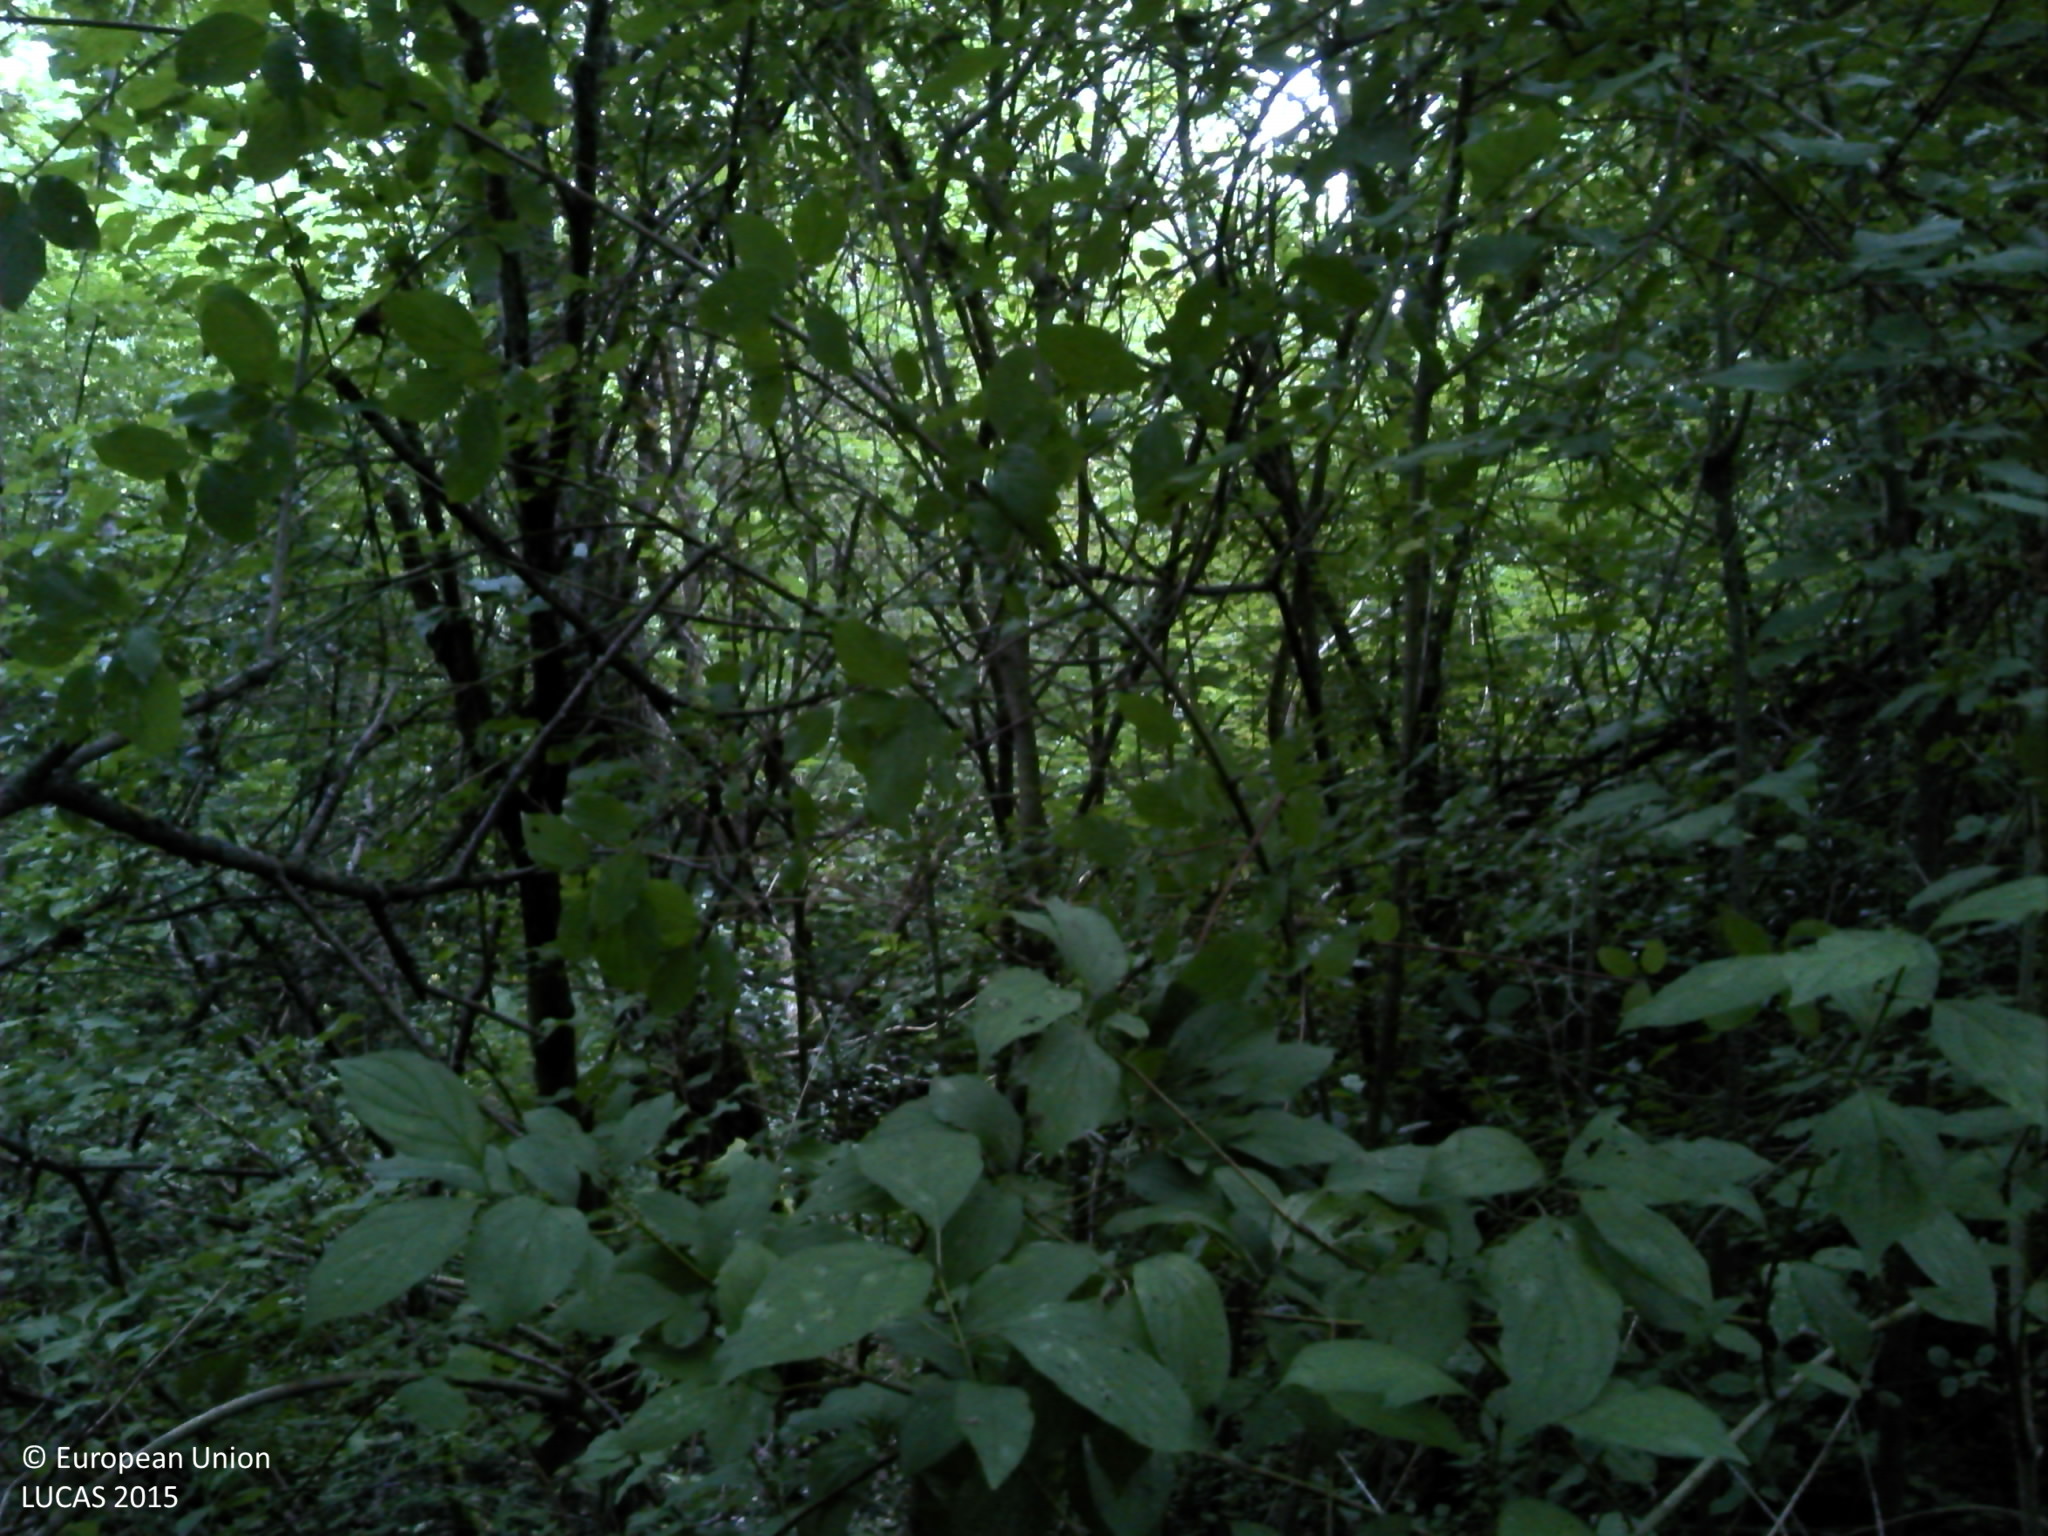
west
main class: Shrubland
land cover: Shrubland with sparse tree cover
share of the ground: > 75 %
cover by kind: shrubs 95 %, broadleaved forest trees 5 %
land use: Semi-natural and natural areas not in use
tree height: < 5 m
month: August
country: HR
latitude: 45.4288
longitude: 16.5294
